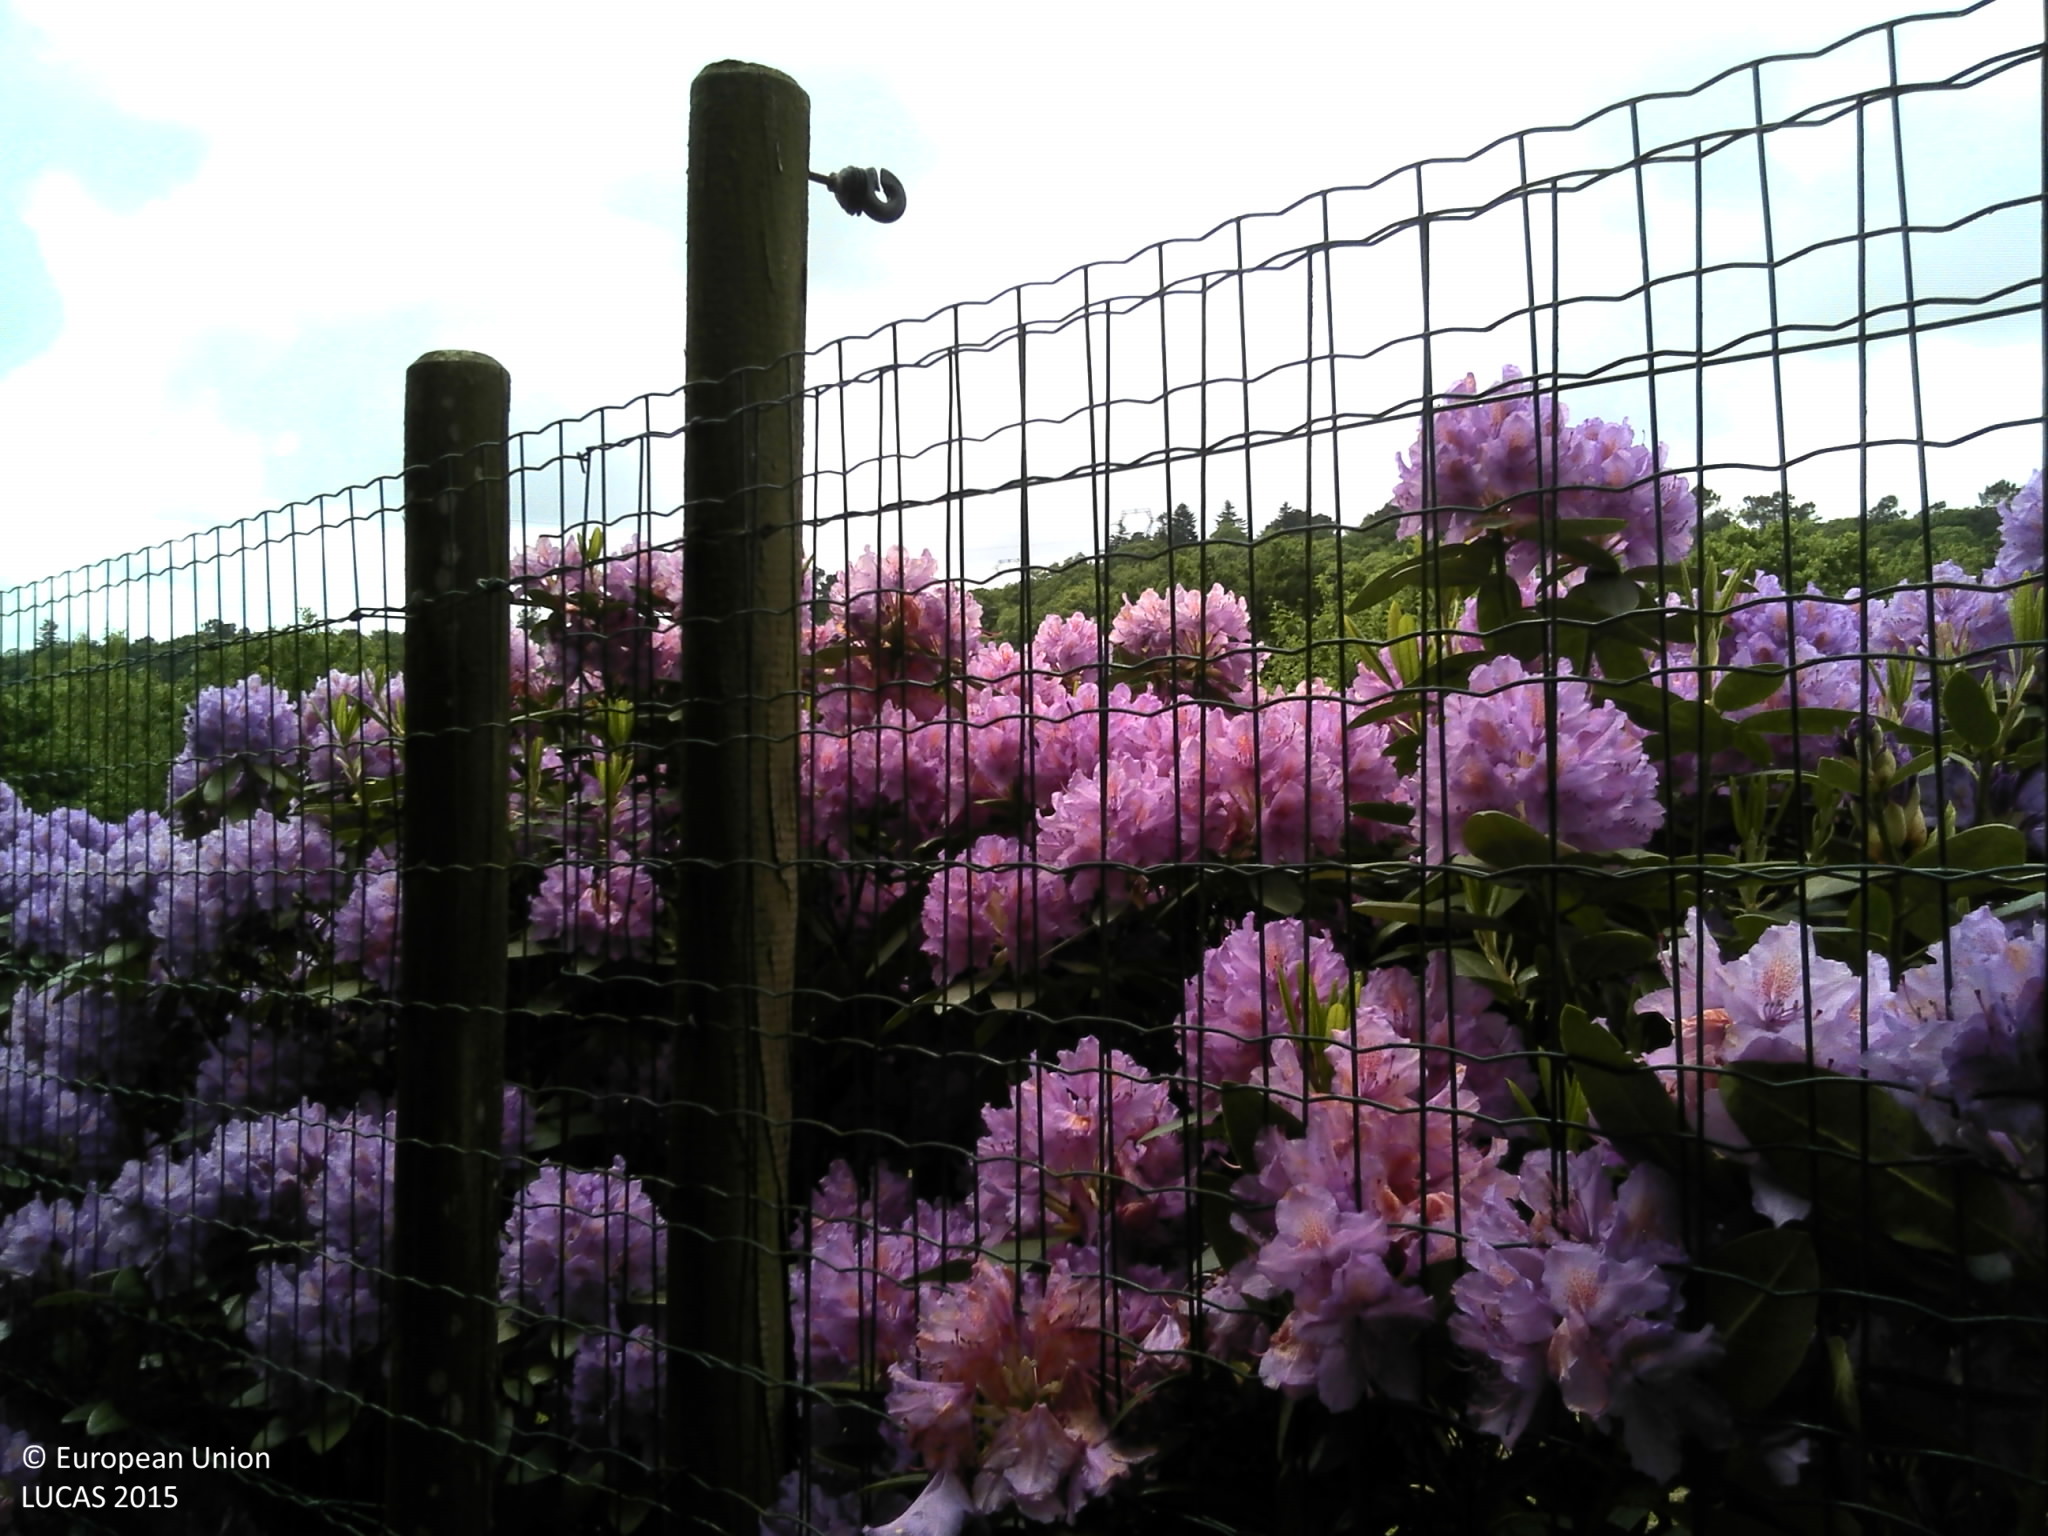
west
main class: Grassland
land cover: Grassland with sparse tree/shrub cover
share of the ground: > 75 %
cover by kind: herbaceous plants 85 %, shrubs 10 %, broadleaved forest trees 5 %
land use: Residential
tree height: < 5 m
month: May
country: FR
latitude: 47.9001
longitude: -3.4929
